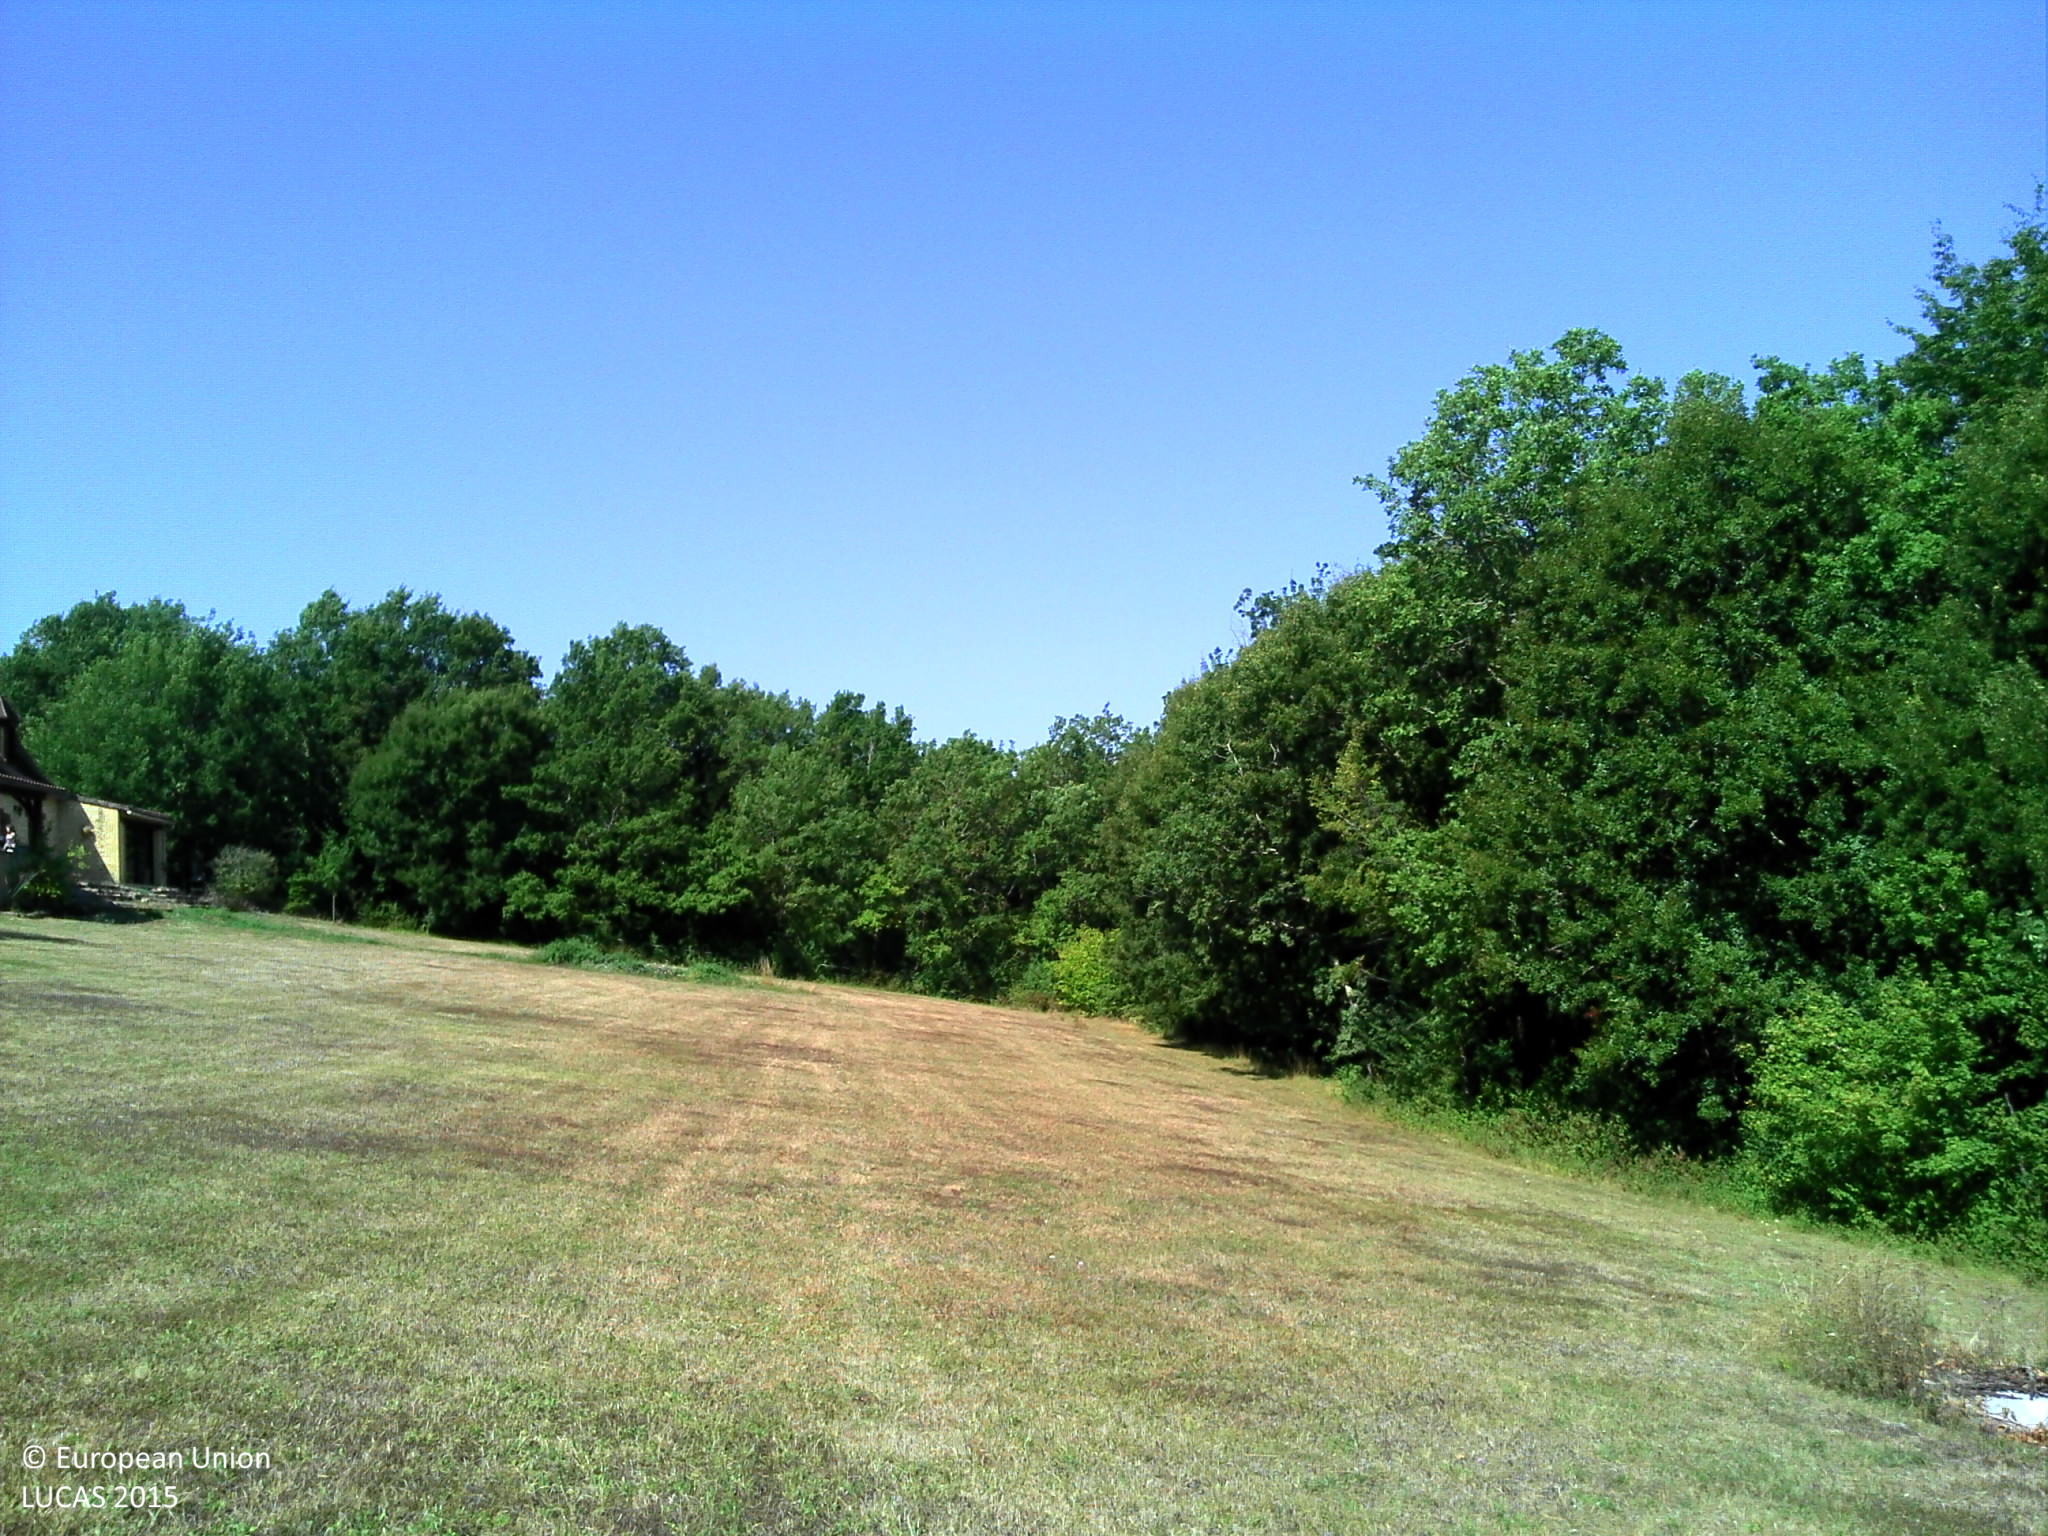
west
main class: Grassland
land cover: Grassland without tree/shrub cover
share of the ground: > 75 %
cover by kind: herbaceous plants 90 %, lichens and mosses 10 %
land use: Residential
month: August
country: FR
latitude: 44.7761
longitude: 0.8059
